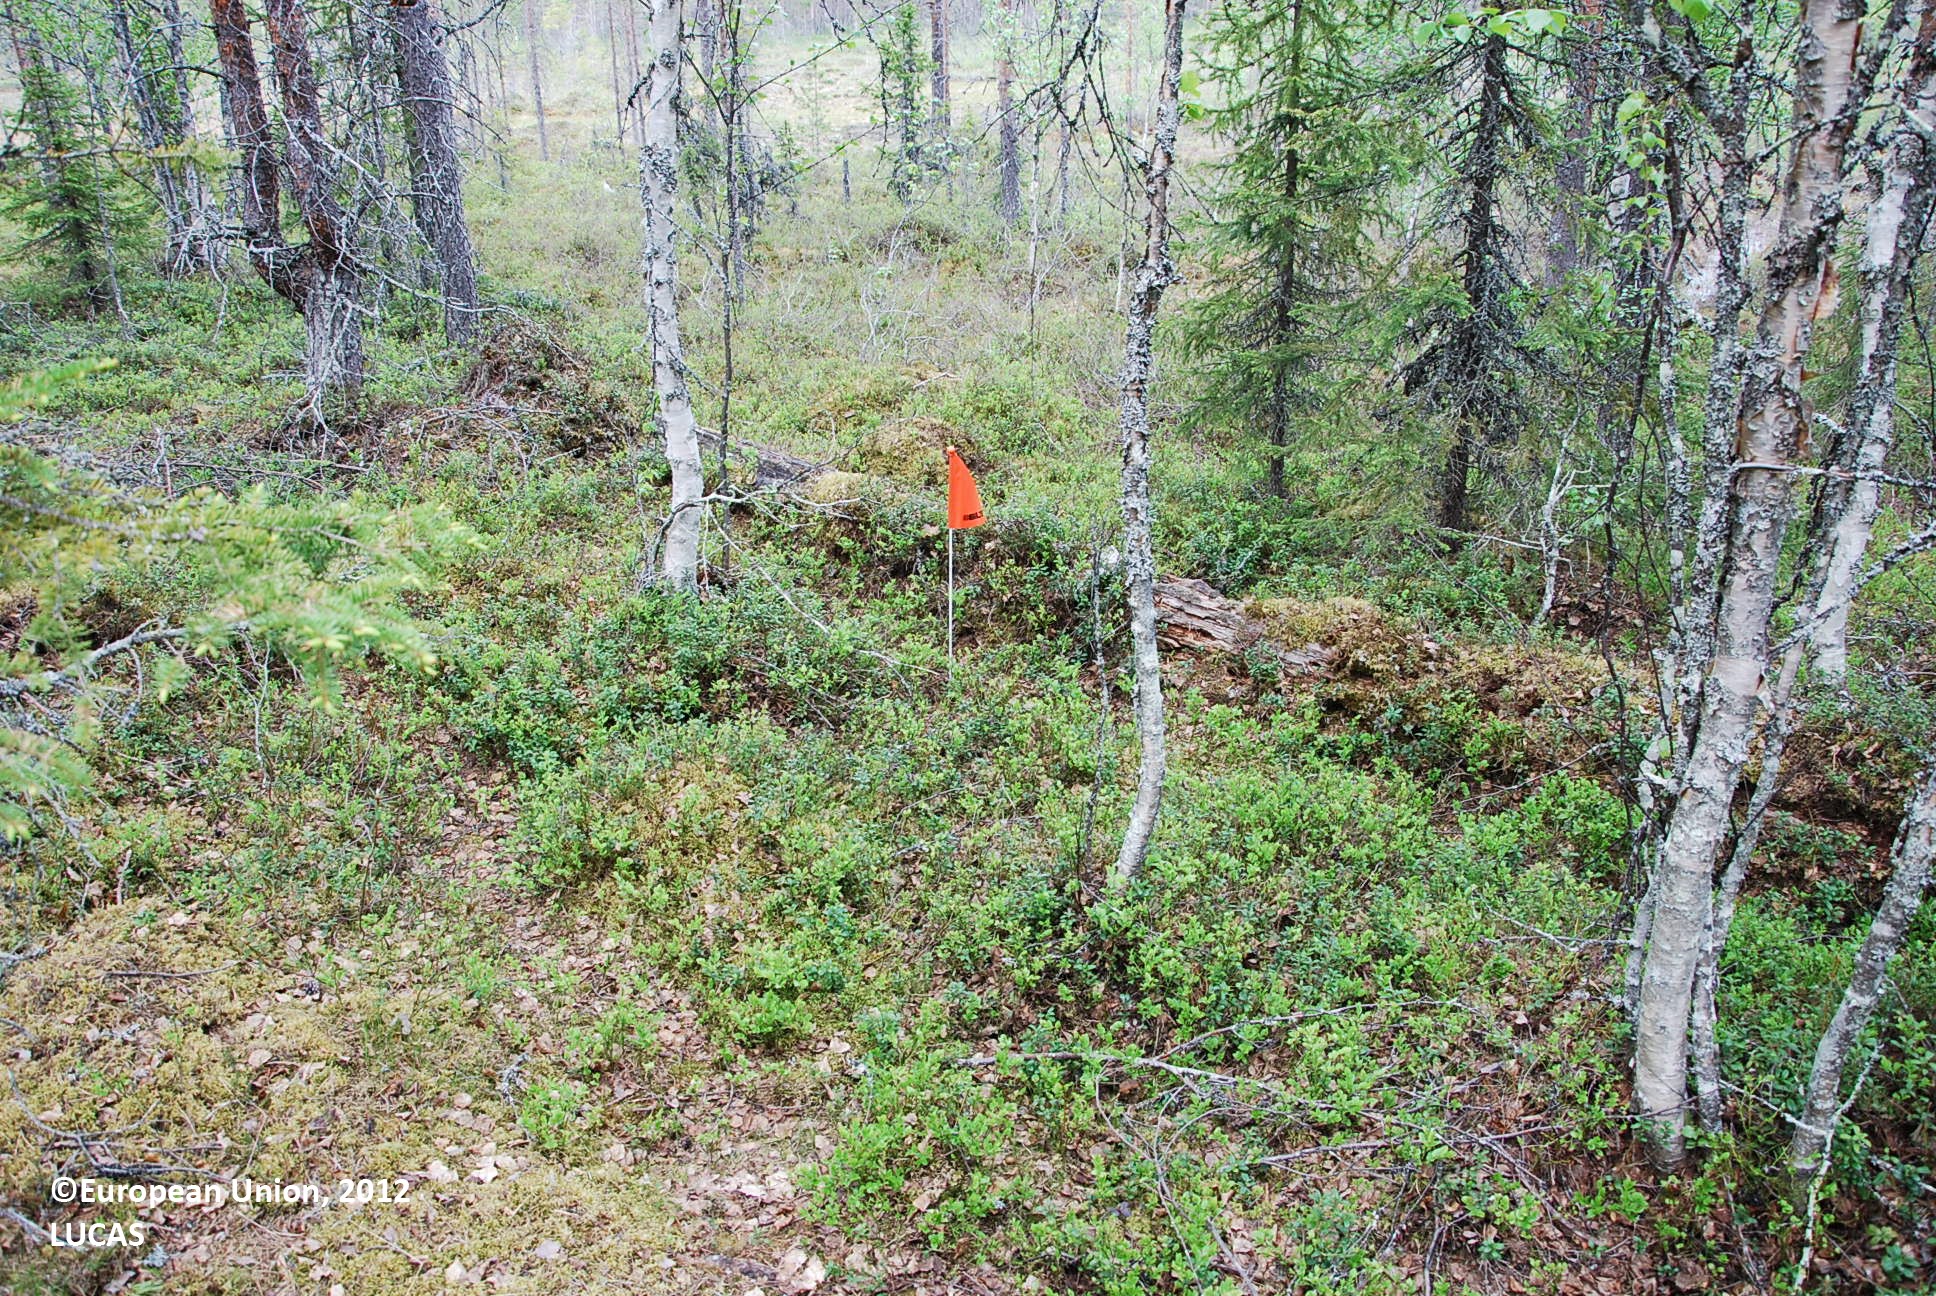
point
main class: Woodland
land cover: Pine dominated mixed woodland
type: boreal forest
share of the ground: > 75 %
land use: Forestry
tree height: > 5 m
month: June
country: FI
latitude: 66.0406
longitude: 27.6708
